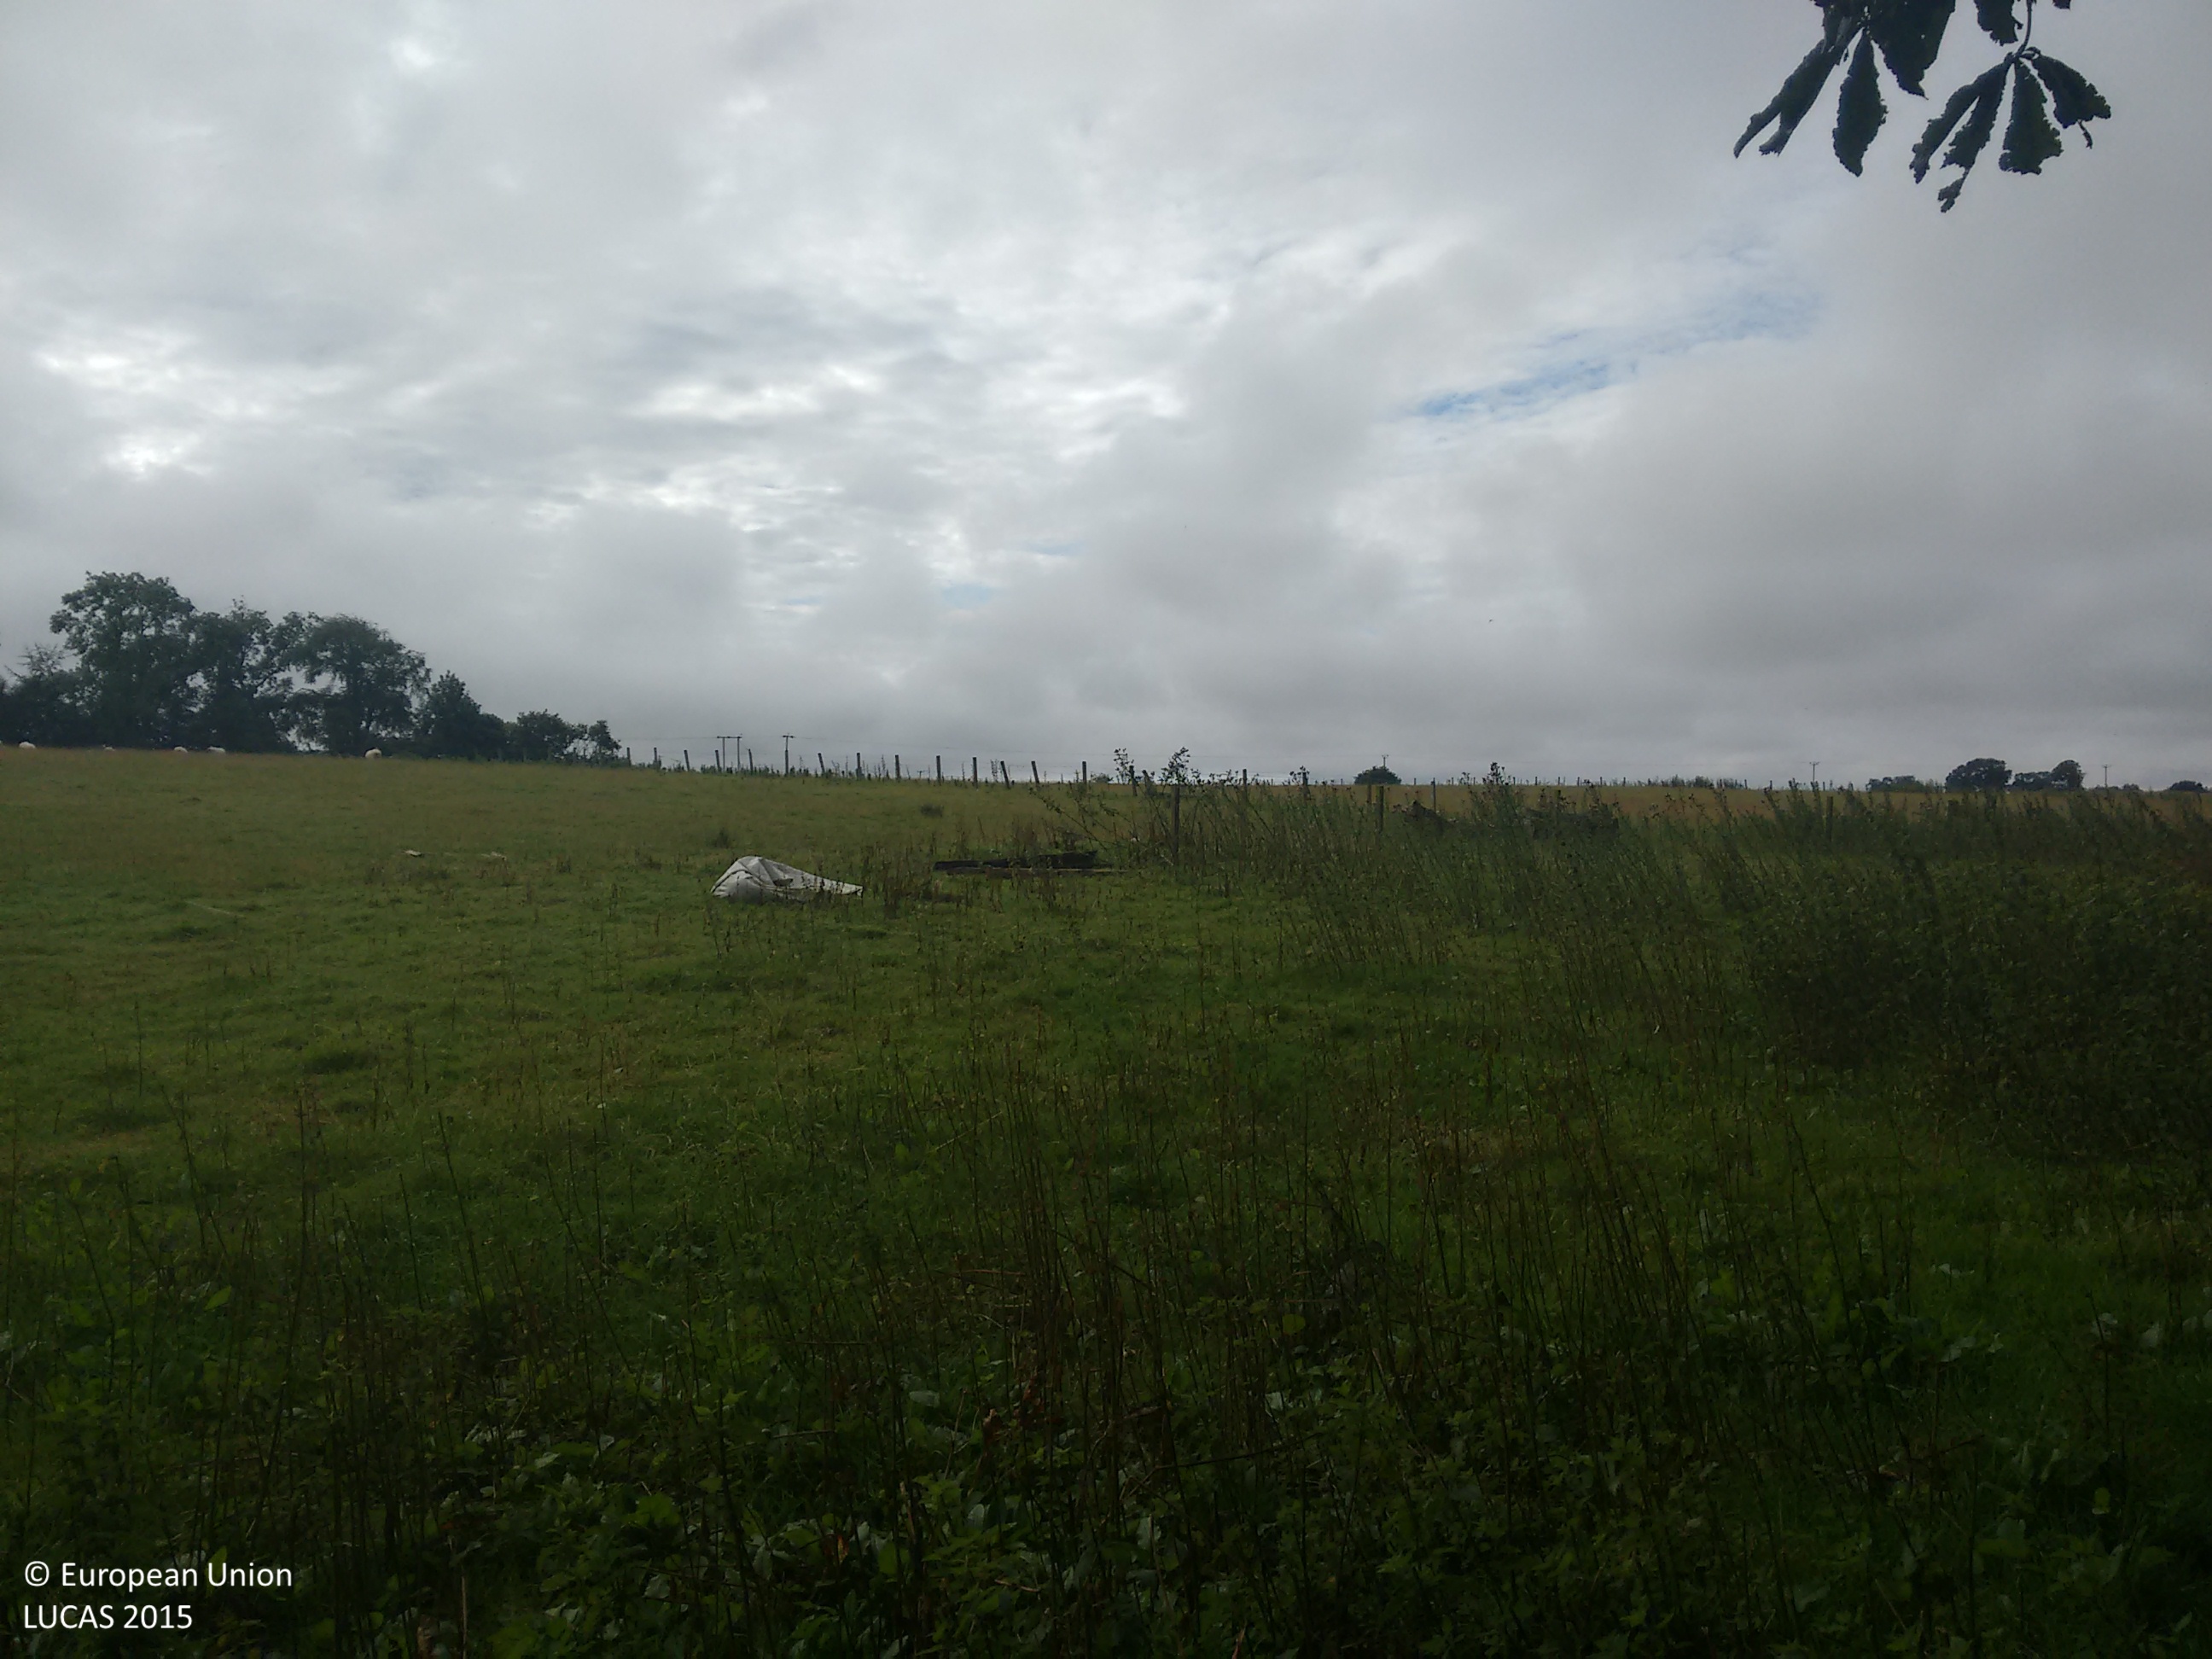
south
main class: Woodland
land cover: Broadleaved woodland
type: beech forest
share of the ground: > 75 %
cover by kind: broadleaved forest trees 100 %
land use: Forestry
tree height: > 5 m
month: August
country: GB
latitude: 57.7726
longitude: -4.0169
